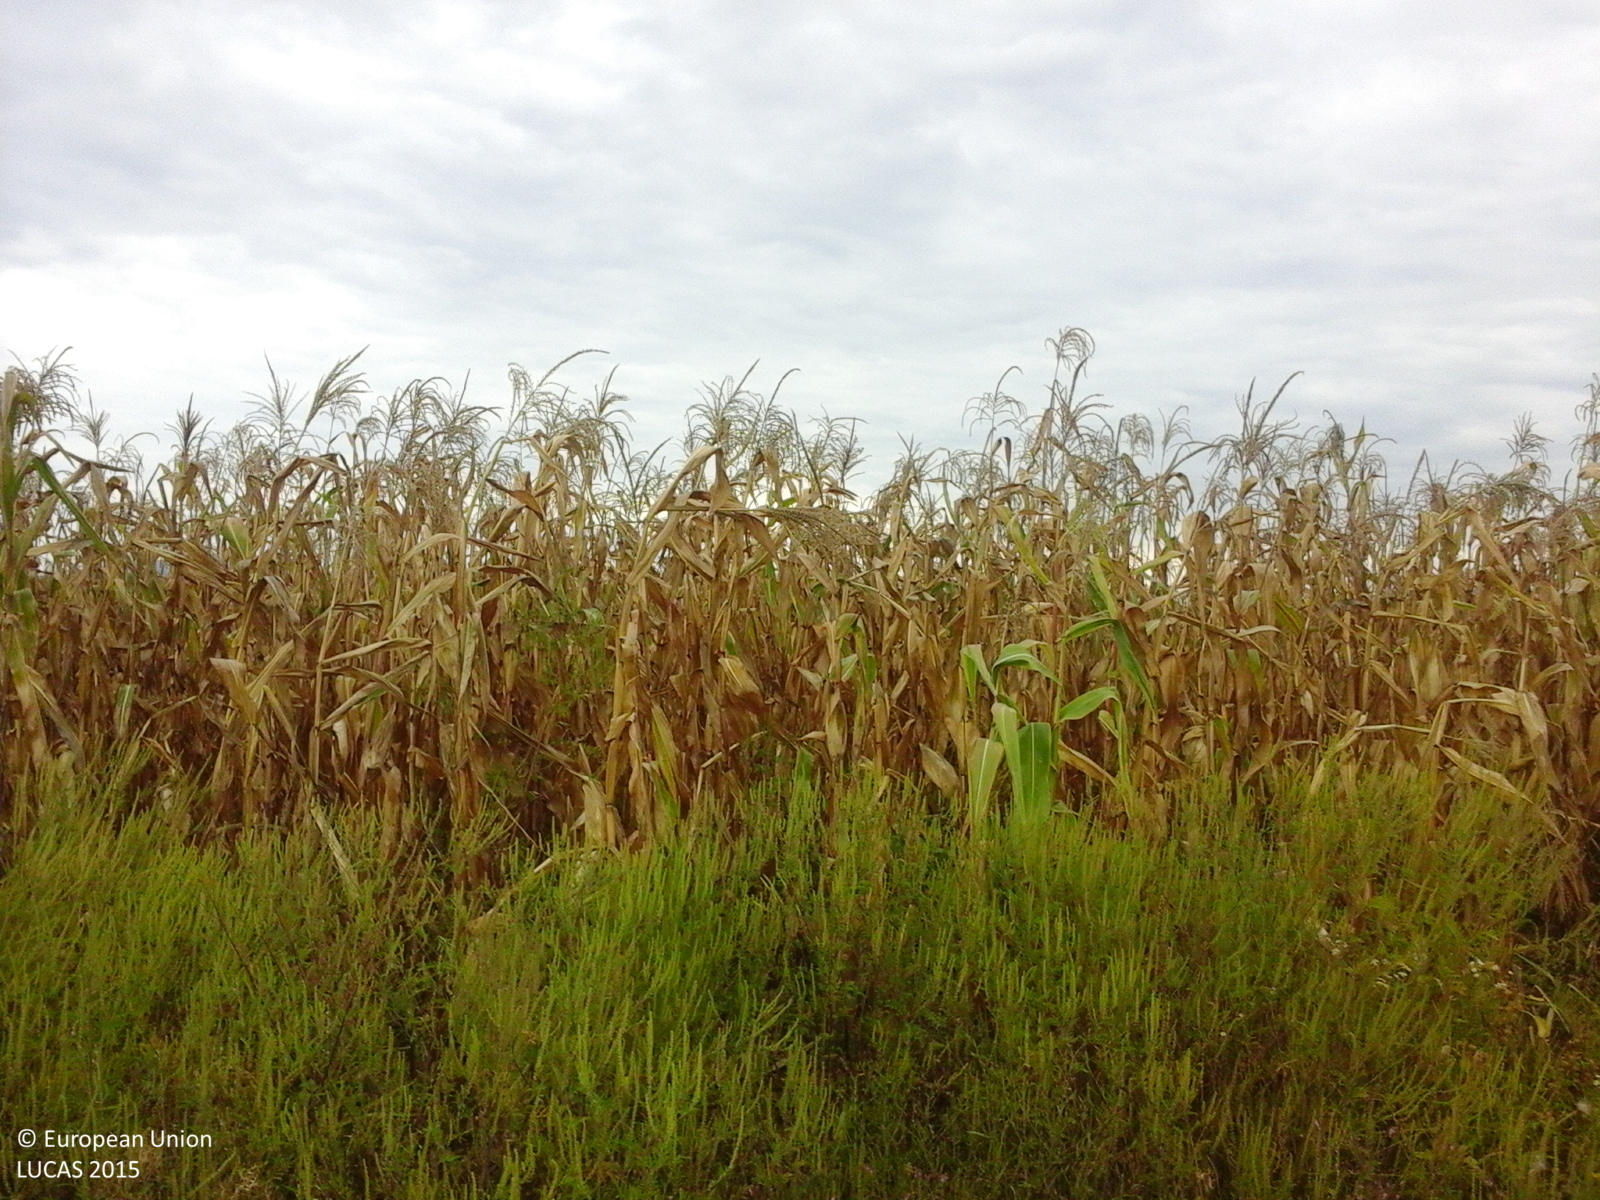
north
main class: Cropland
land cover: Maize
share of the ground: > 75 %
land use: Agriculture (excluding fallow land and kitchen gardens)
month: September
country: RO
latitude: 47.8425
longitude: 23.3686
